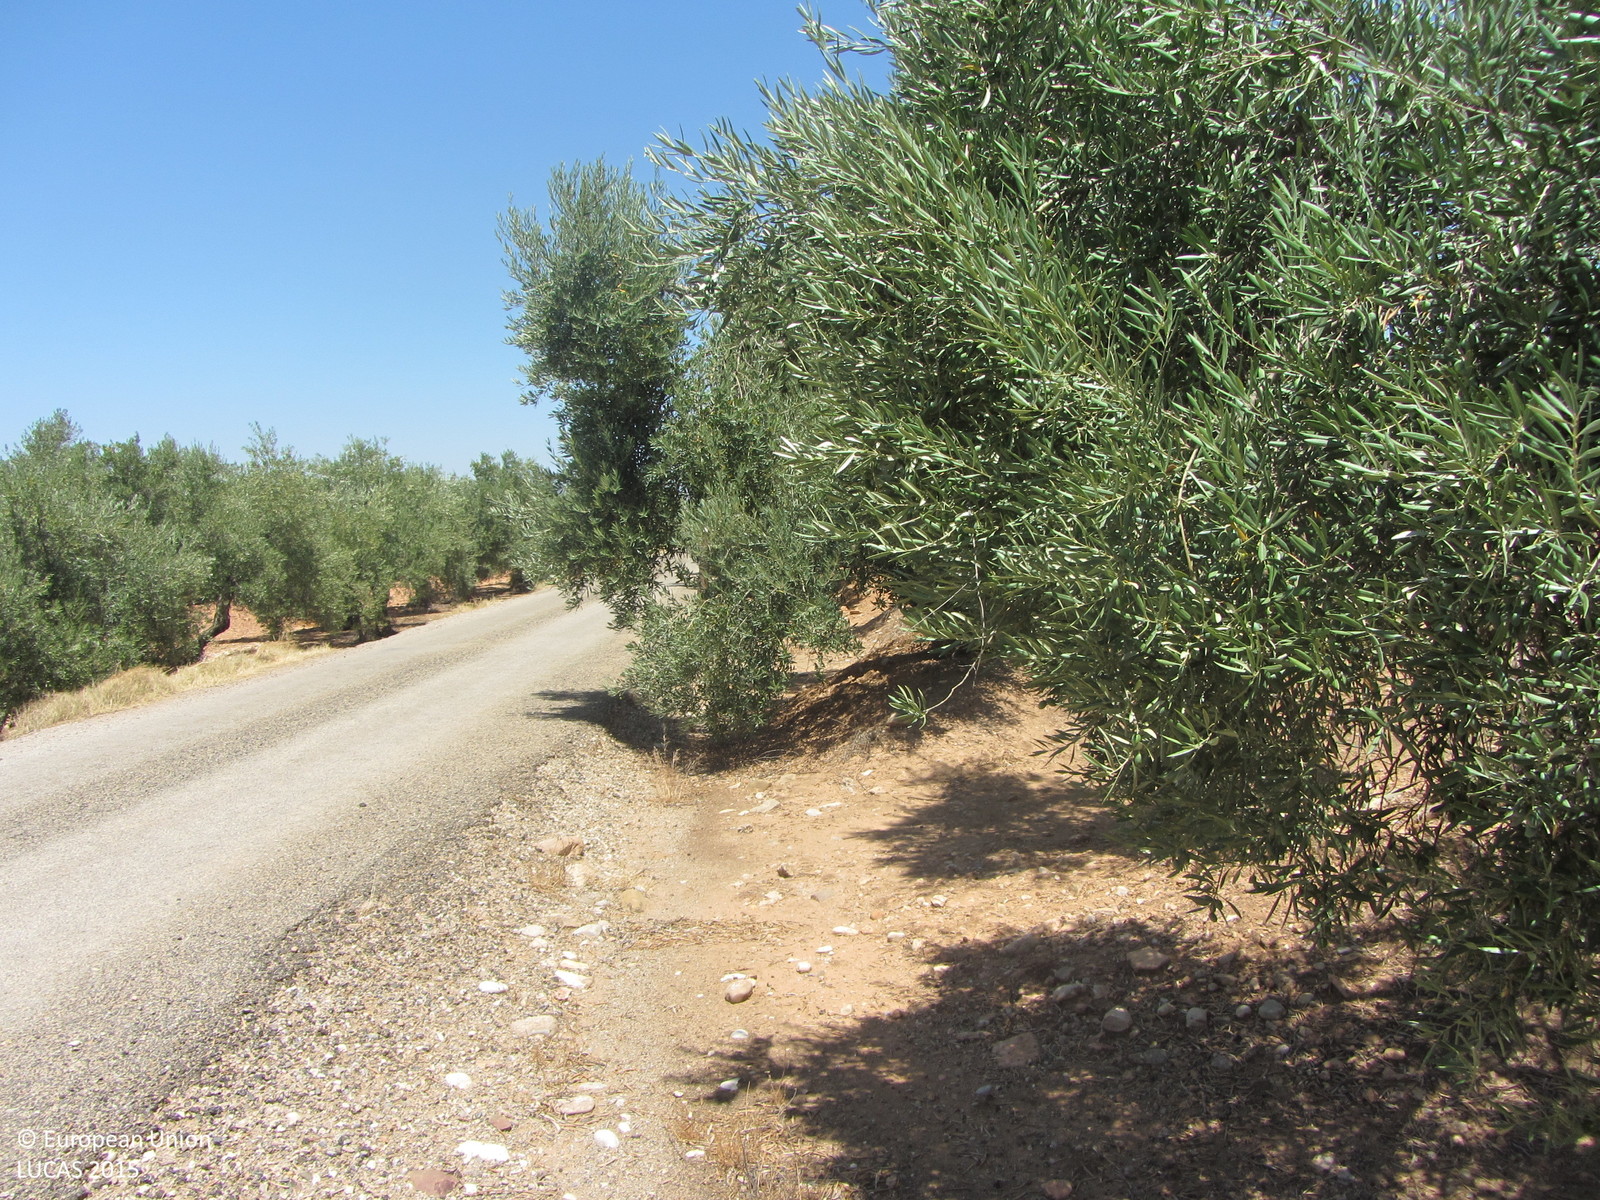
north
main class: Cropland
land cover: Olive groves
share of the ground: 25 - 50 %
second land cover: Other bare soil
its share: > 75 %
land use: Agriculture (excluding fallow land and kitchen gardens)
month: July
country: ES
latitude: 38.0296
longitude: -3.8702
